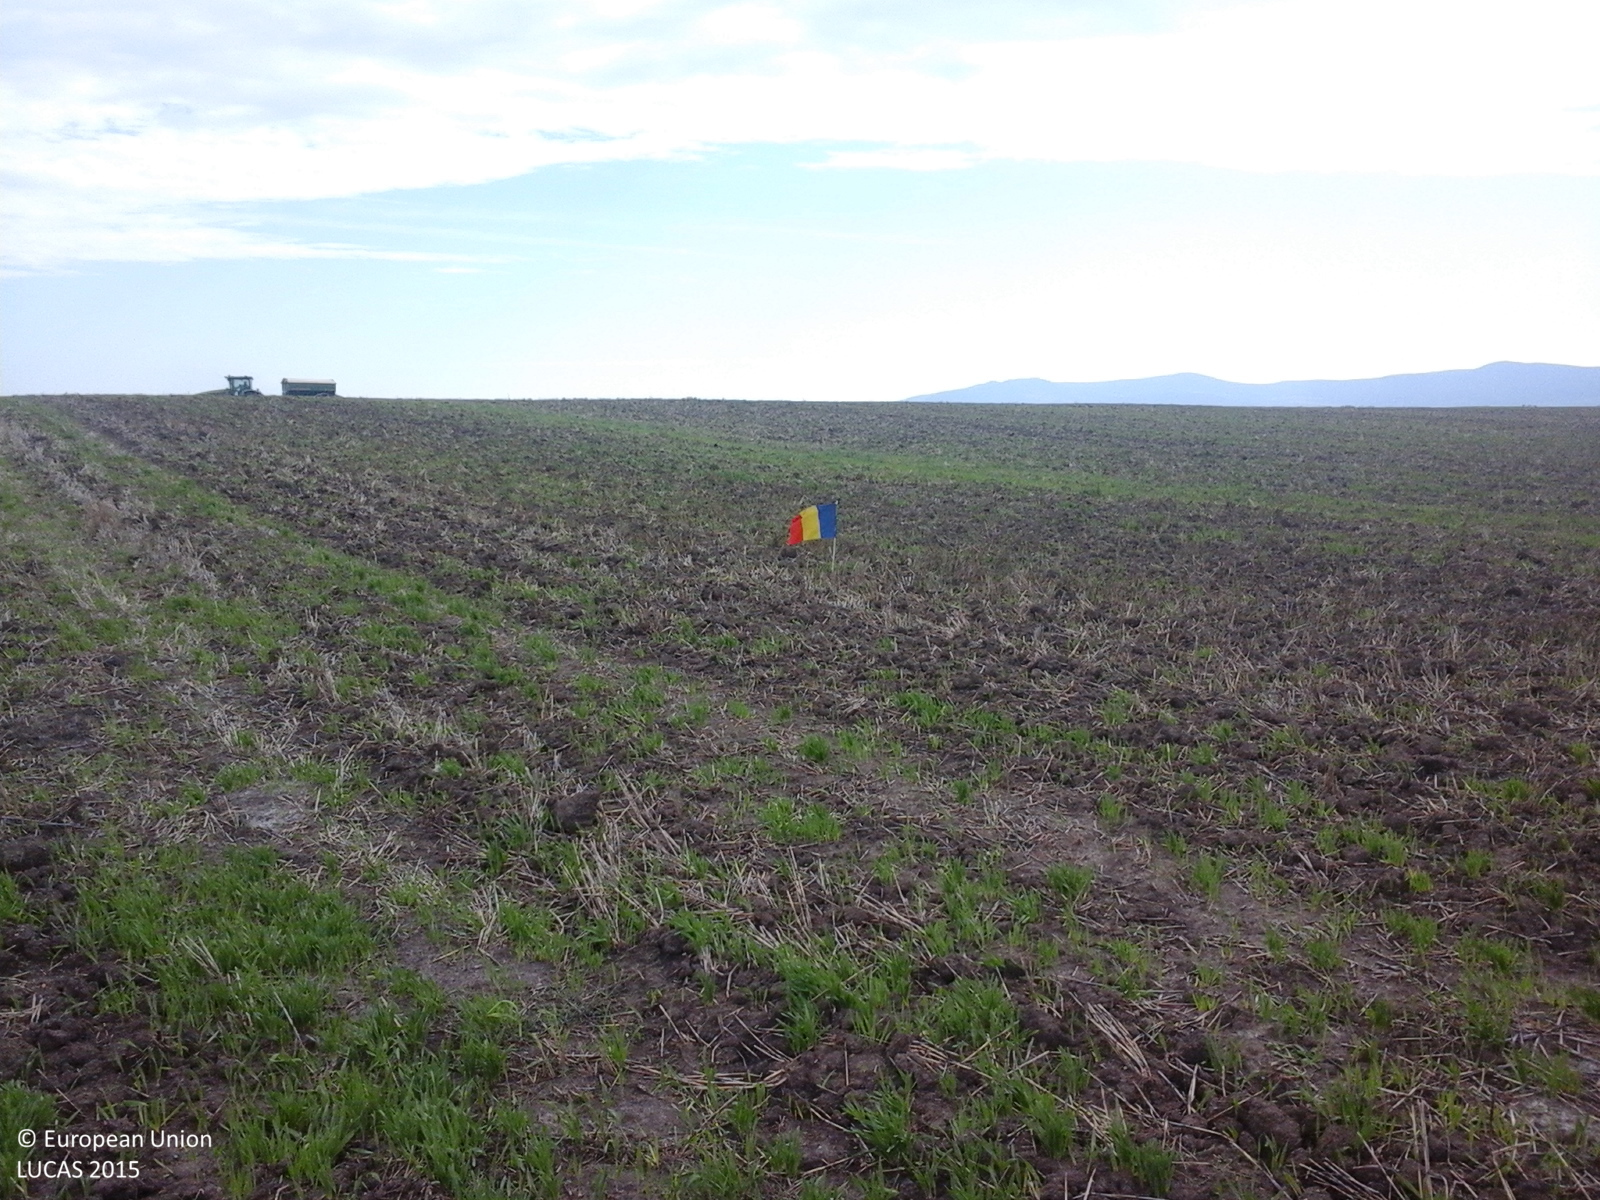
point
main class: Cropland
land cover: Common wheat
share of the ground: < 10 %
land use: Agriculture (excluding fallow land and kitchen gardens)
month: August
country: RO
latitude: 46.2570
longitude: 21.4912
